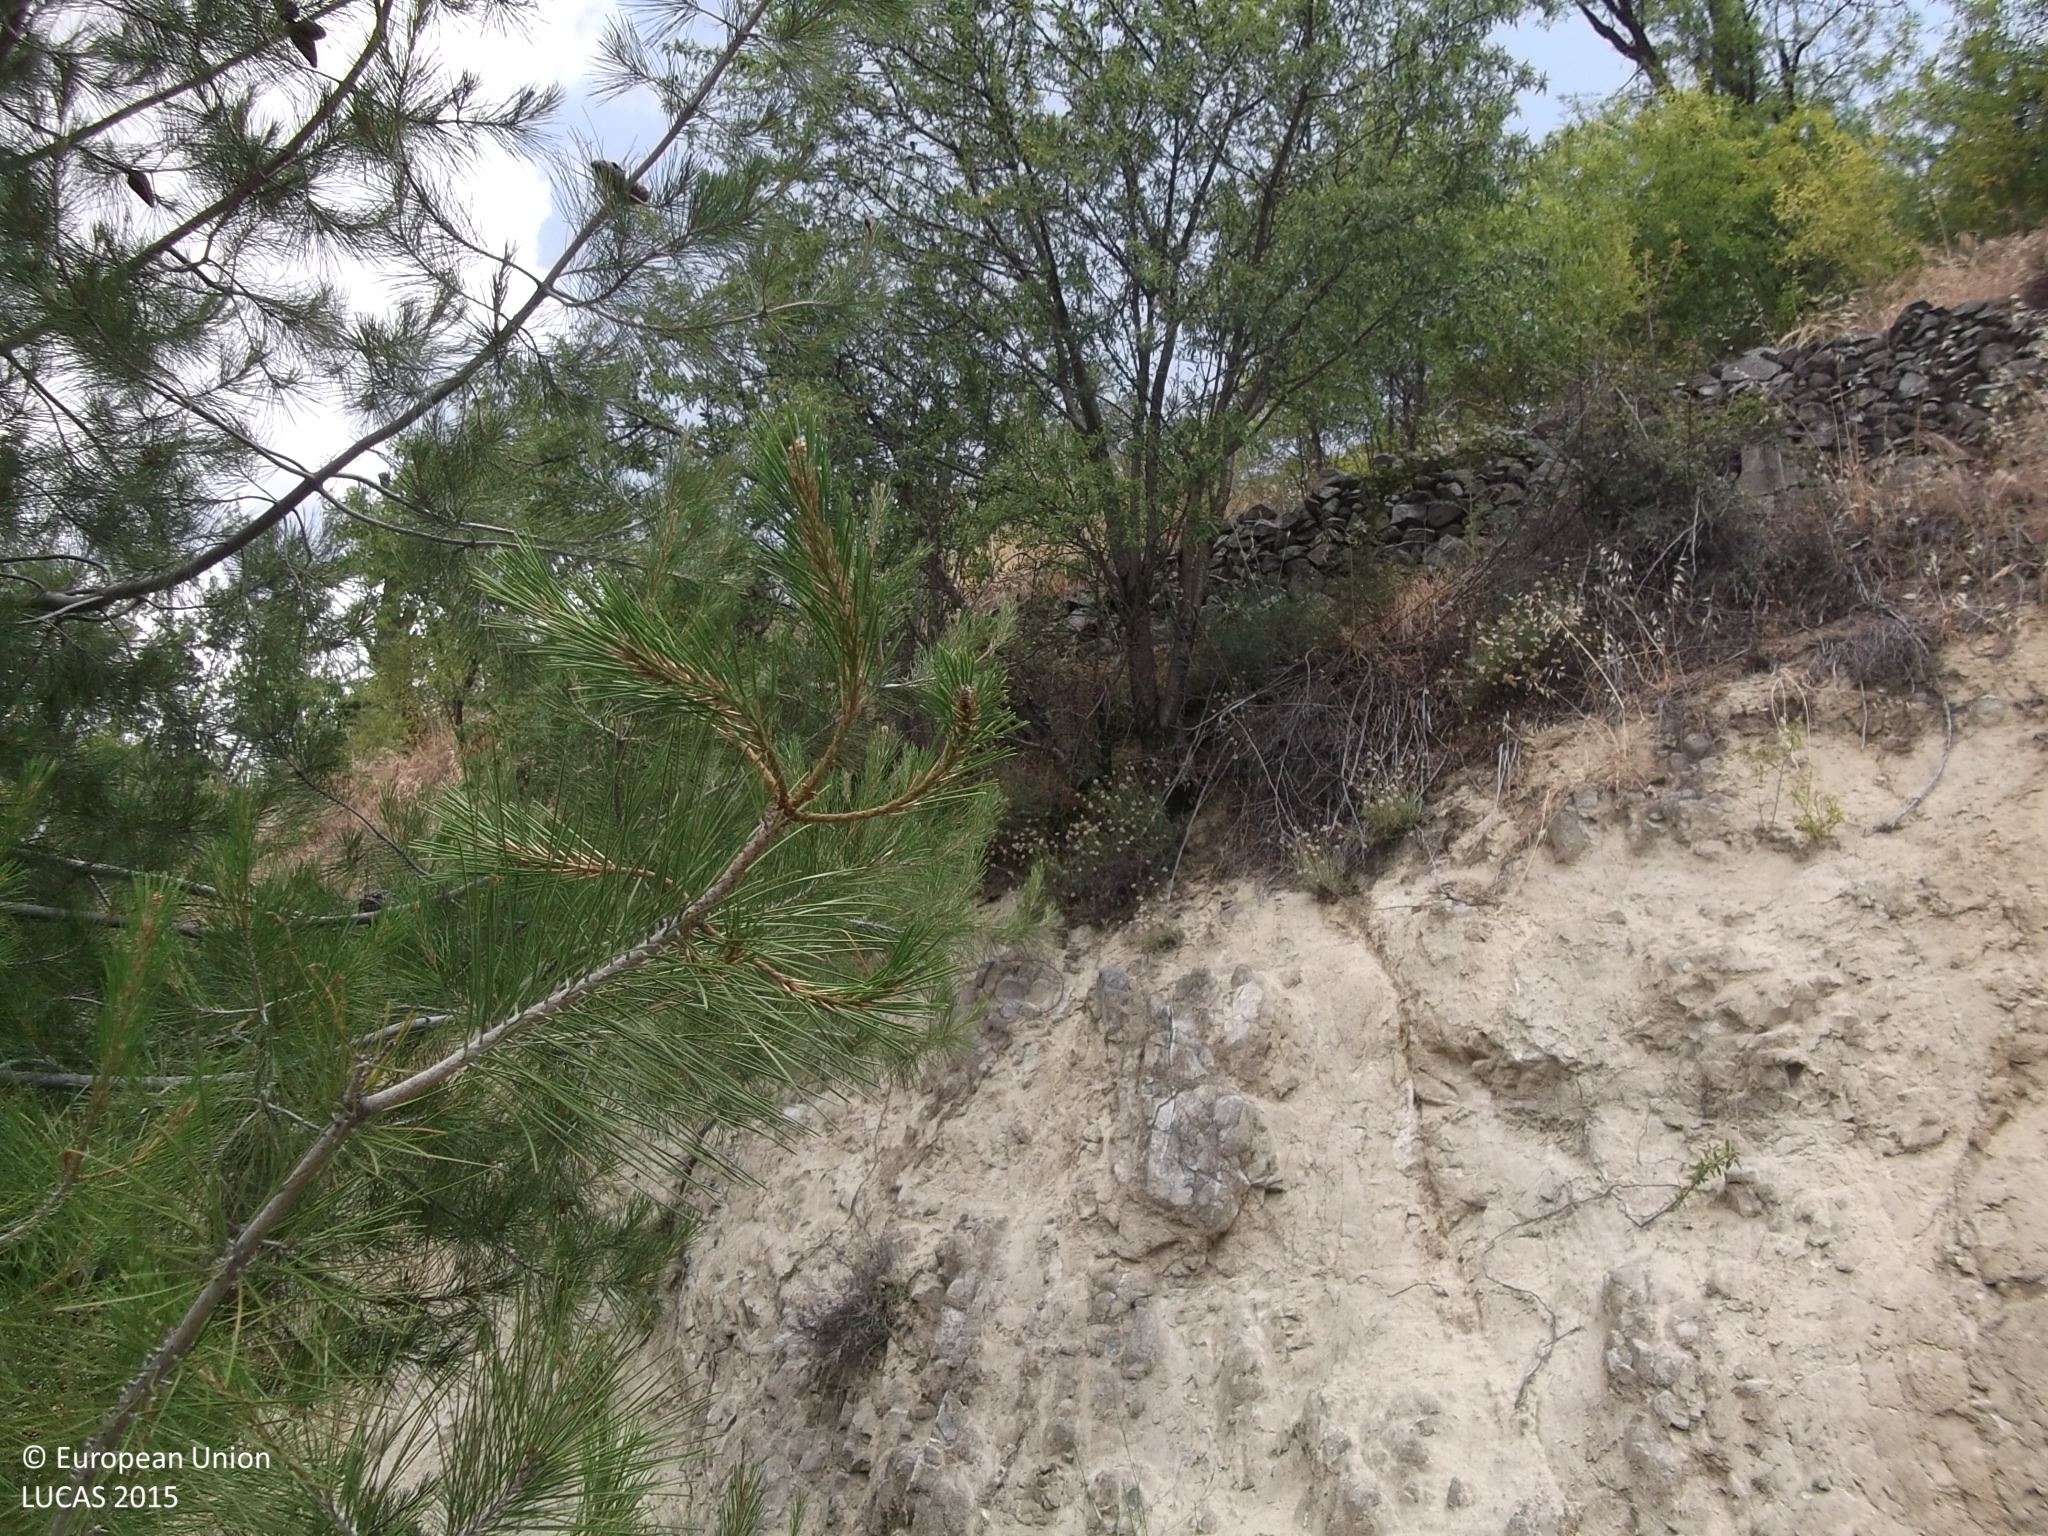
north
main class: Cropland
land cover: Nuts trees
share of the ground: 25 - 50 %
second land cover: Grassland without tree/shrub cover
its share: > 75 %
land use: Agriculture (excluding fallow land and kitchen gardens)
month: June
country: CY
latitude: 34.8971
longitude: 32.9634
